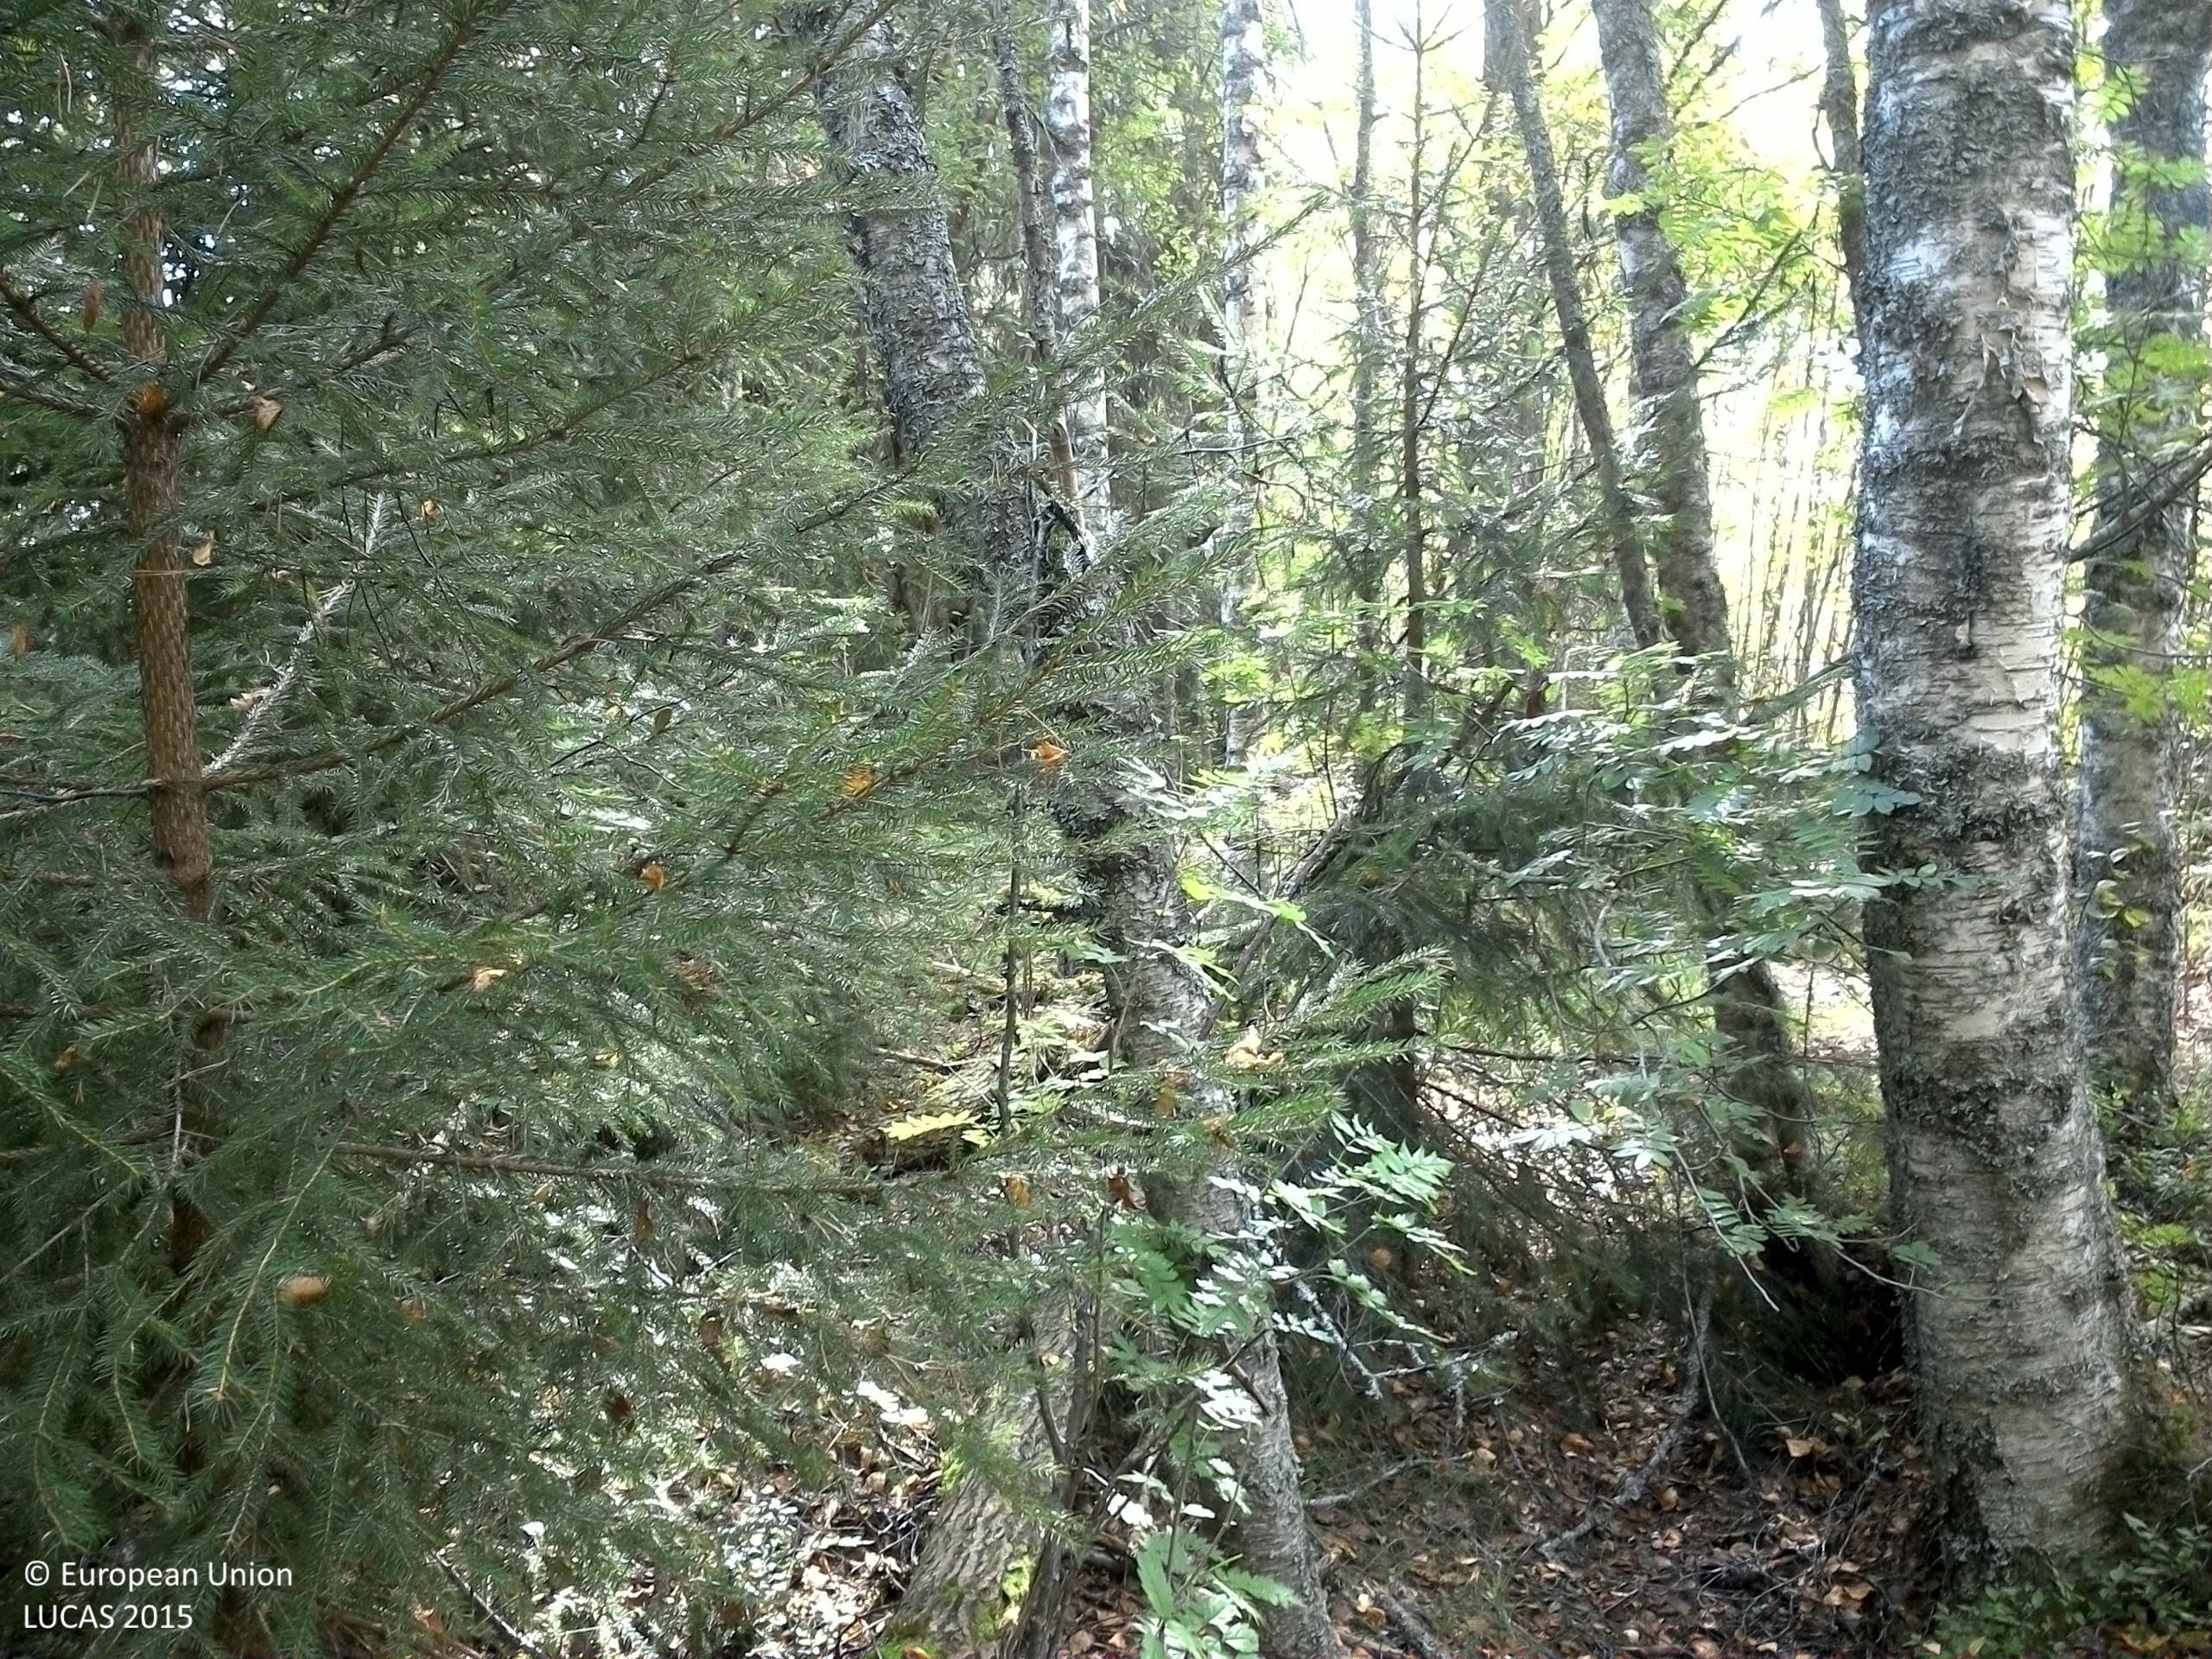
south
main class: Woodland
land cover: Pine dominated mixed woodland
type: boreal forest
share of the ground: 50 - 75 %
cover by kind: coniferous forest trees 50 %, broadleaved forest trees 20 %, shrubs 20 %, lichens and mosses 10 %
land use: Forestry
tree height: > 5 m
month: September
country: SE
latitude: 59.7948
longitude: 13.5018
